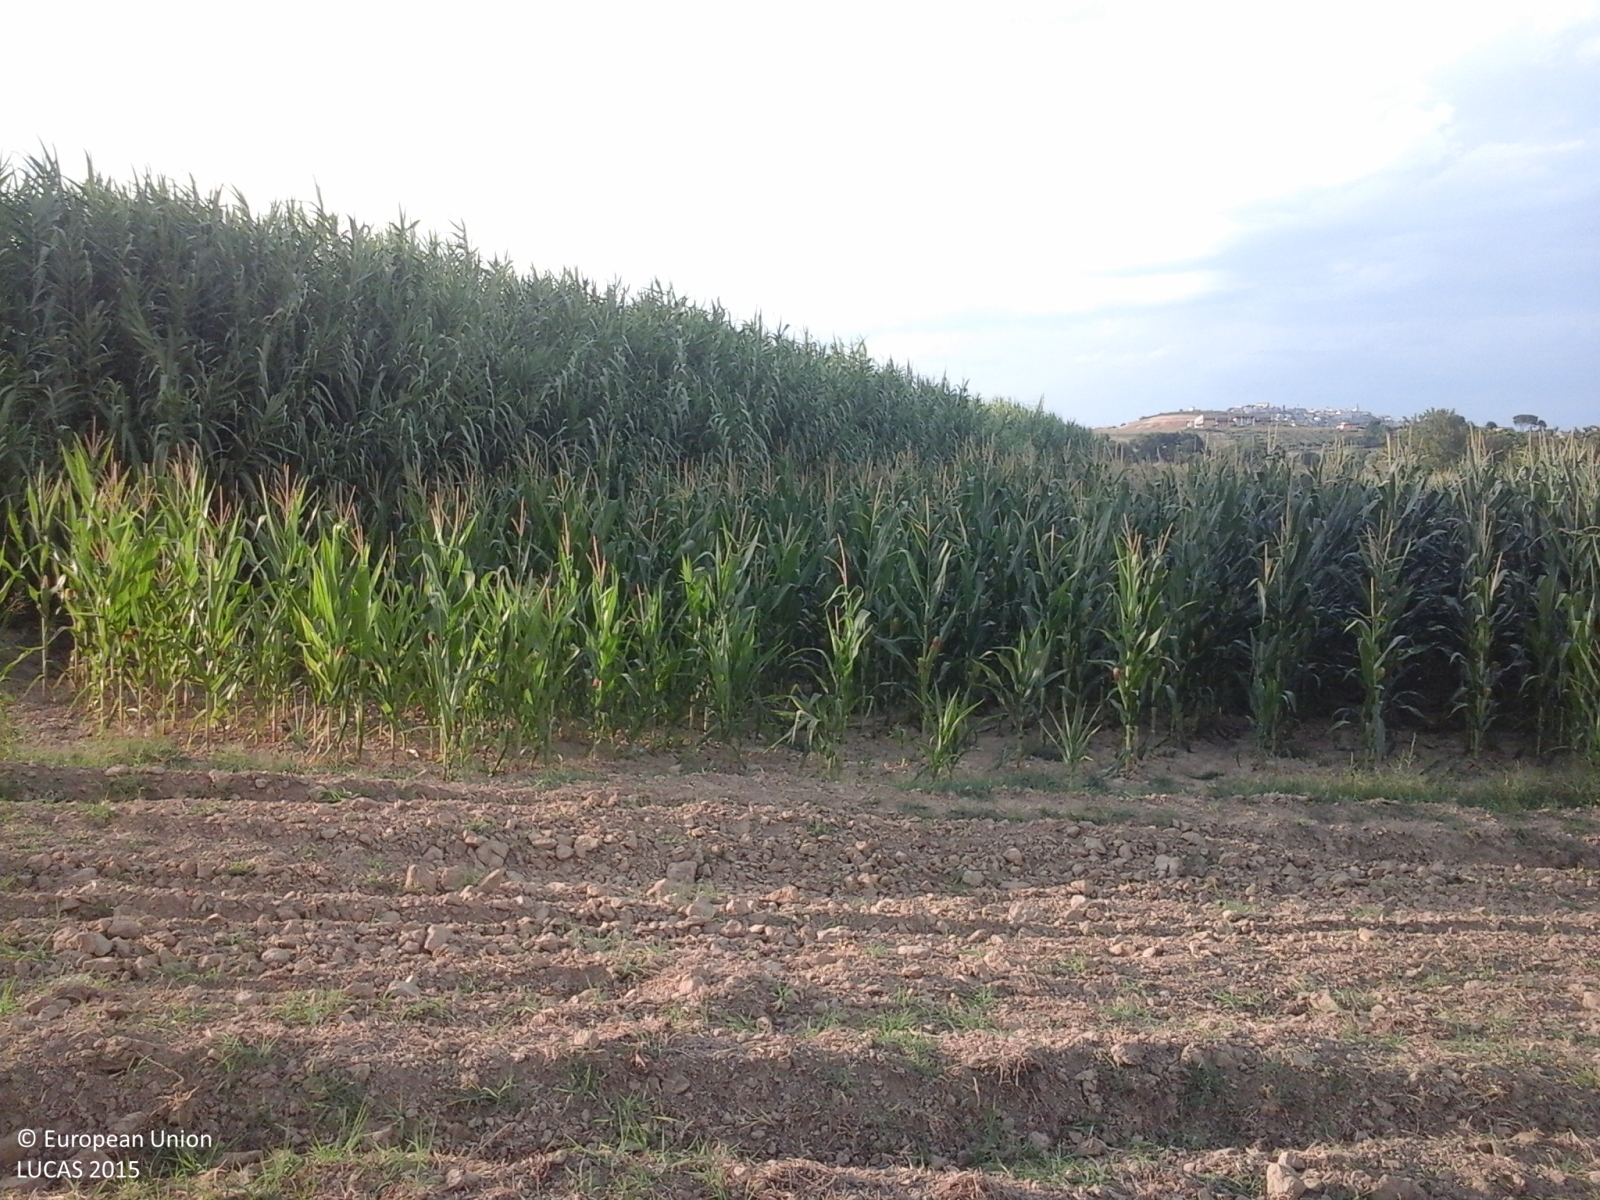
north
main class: Grassland
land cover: Spontaneously vegetated surfaces
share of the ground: > 75 %
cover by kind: herbaceous plants 80 %, unconsolidated bare surface 20 %
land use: Agriculture (excluding fallow land and kitchen gardens)
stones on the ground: < 10 %
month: August
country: IT
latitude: 42.4831
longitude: 14.0390
